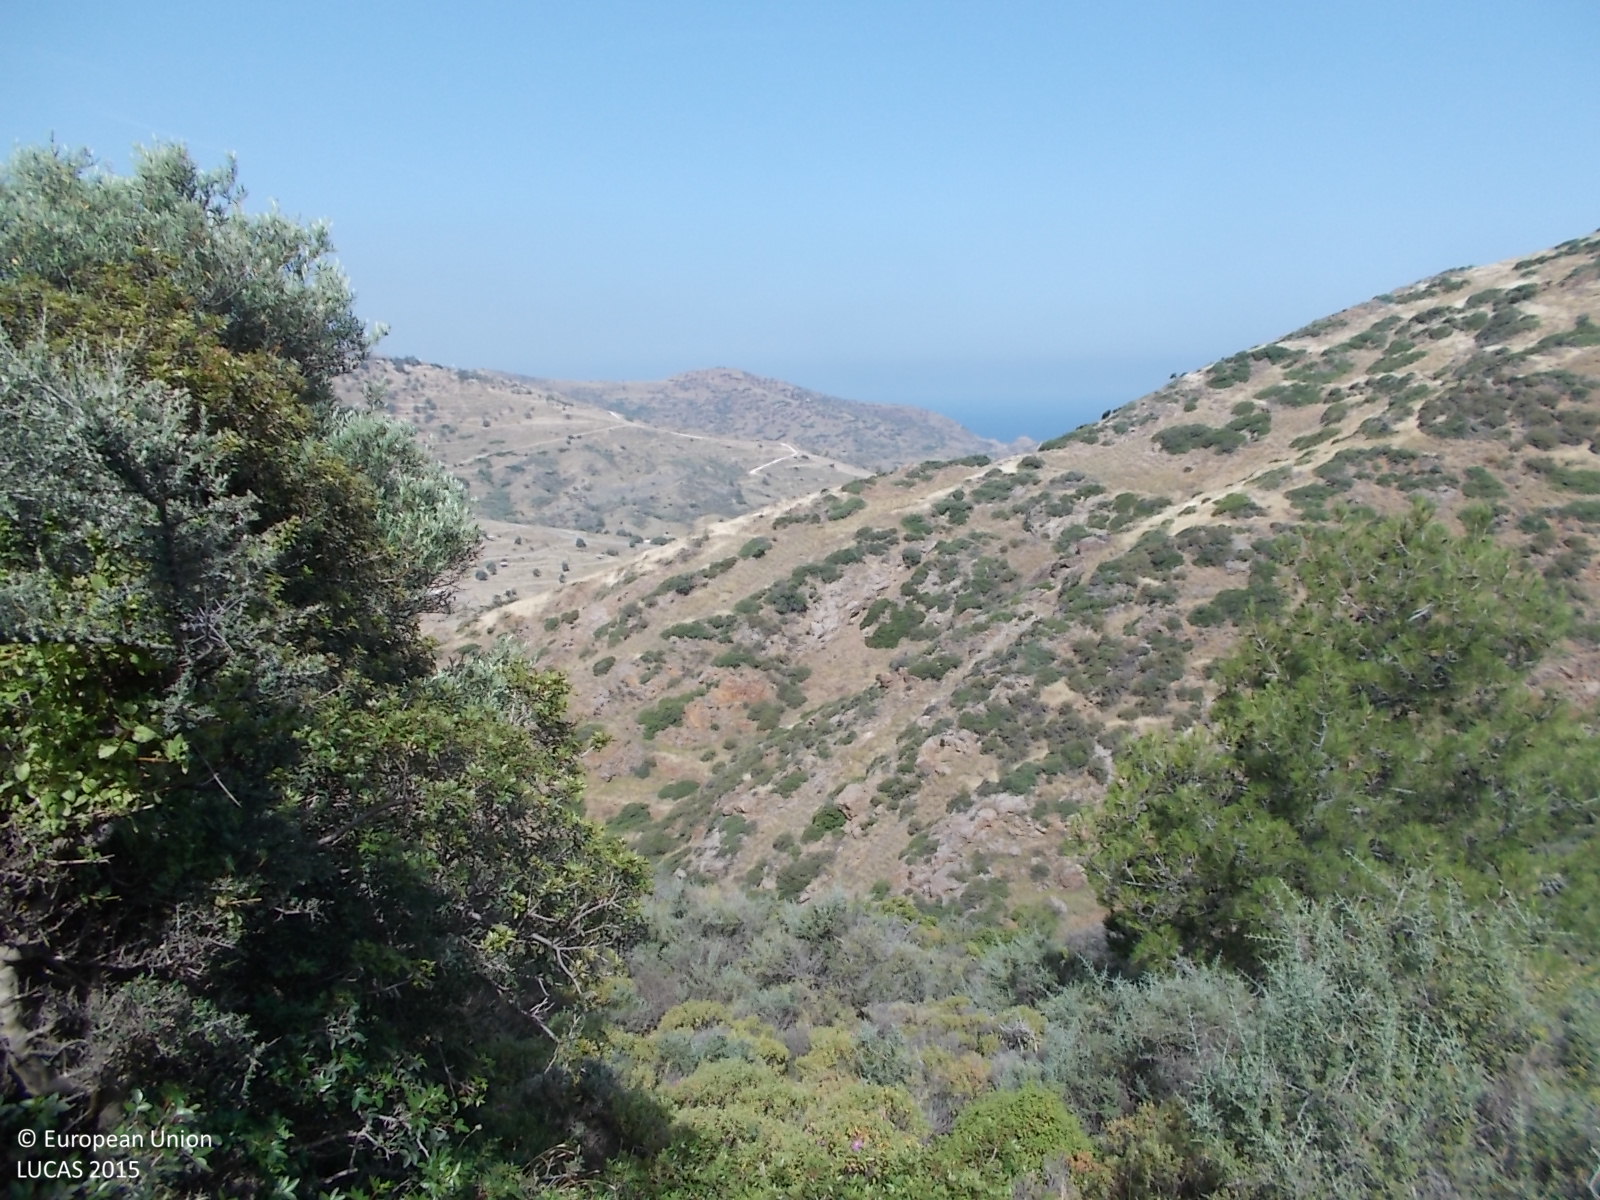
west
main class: Shrubland
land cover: Shrubland with sparse tree cover
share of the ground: 50 - 75 %
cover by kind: shrubs 70 %, herbaceous plants 15 %, consolidated bare surface 10 %, coniferous forest trees 5 %
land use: Semi-natural and natural areas not in use
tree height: > 5 m
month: May
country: CY
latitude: 35.1837
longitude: 32.6451
